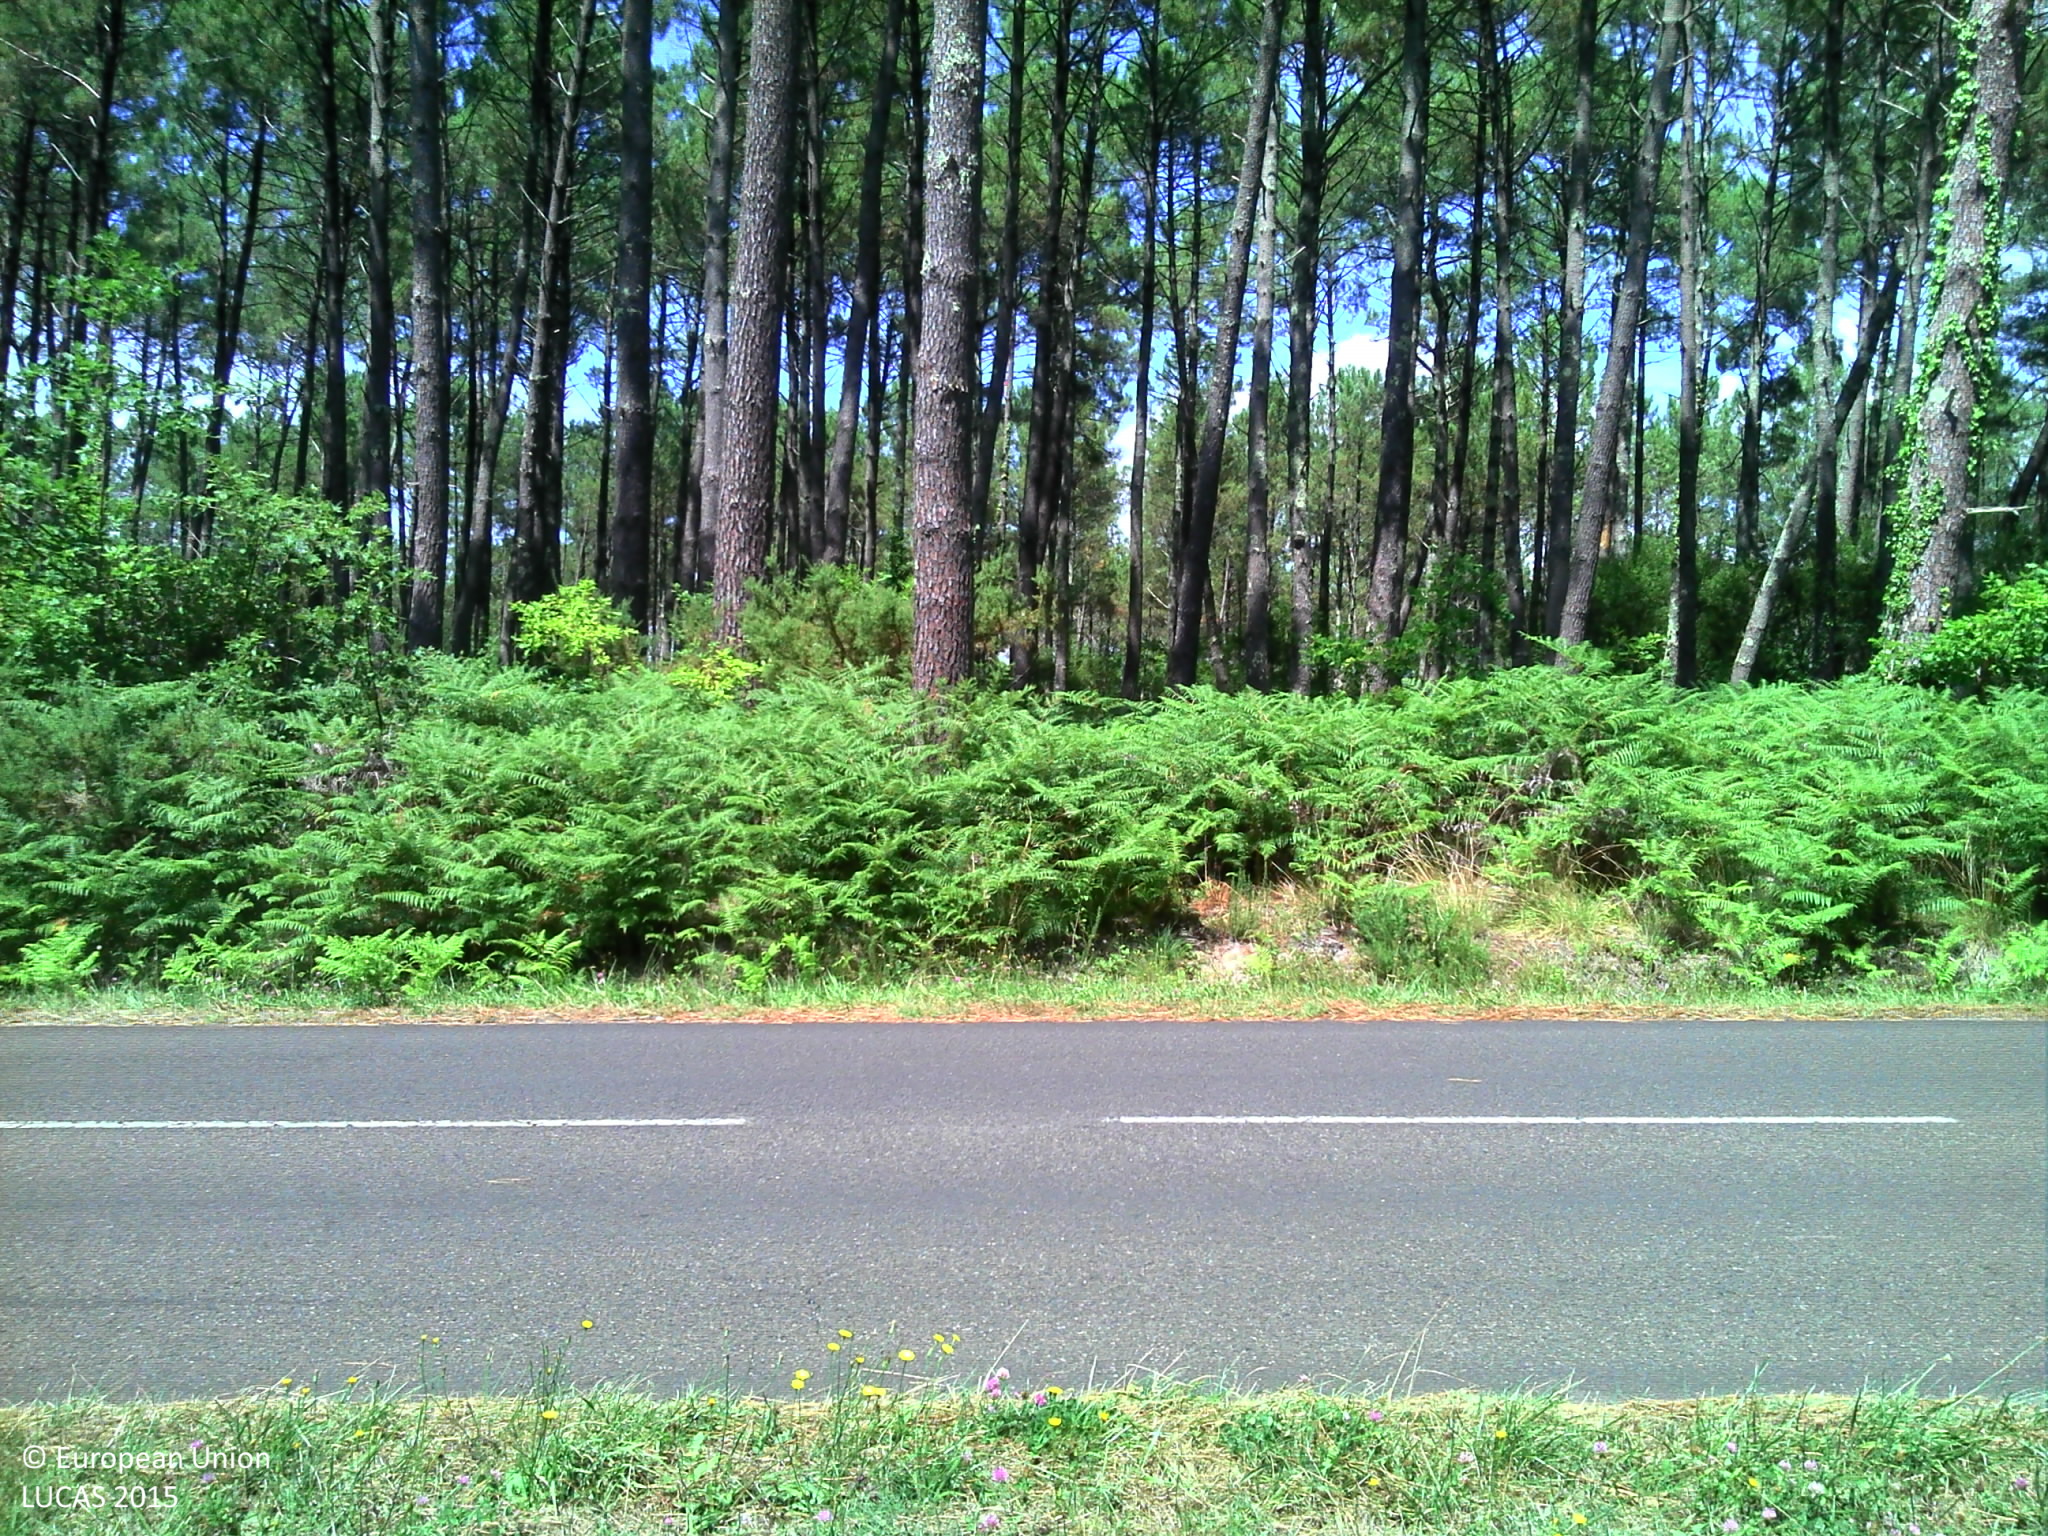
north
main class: Woodland
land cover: Broadleaved woodland
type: thermophilous deciduous forest
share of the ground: > 75 %
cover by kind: broadleaved forest trees 80 %, shrubs 10 %, herbaceous plants 10 %
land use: Forestry
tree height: > 5 m
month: July
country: FR
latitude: 44.0801
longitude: -1.2719
